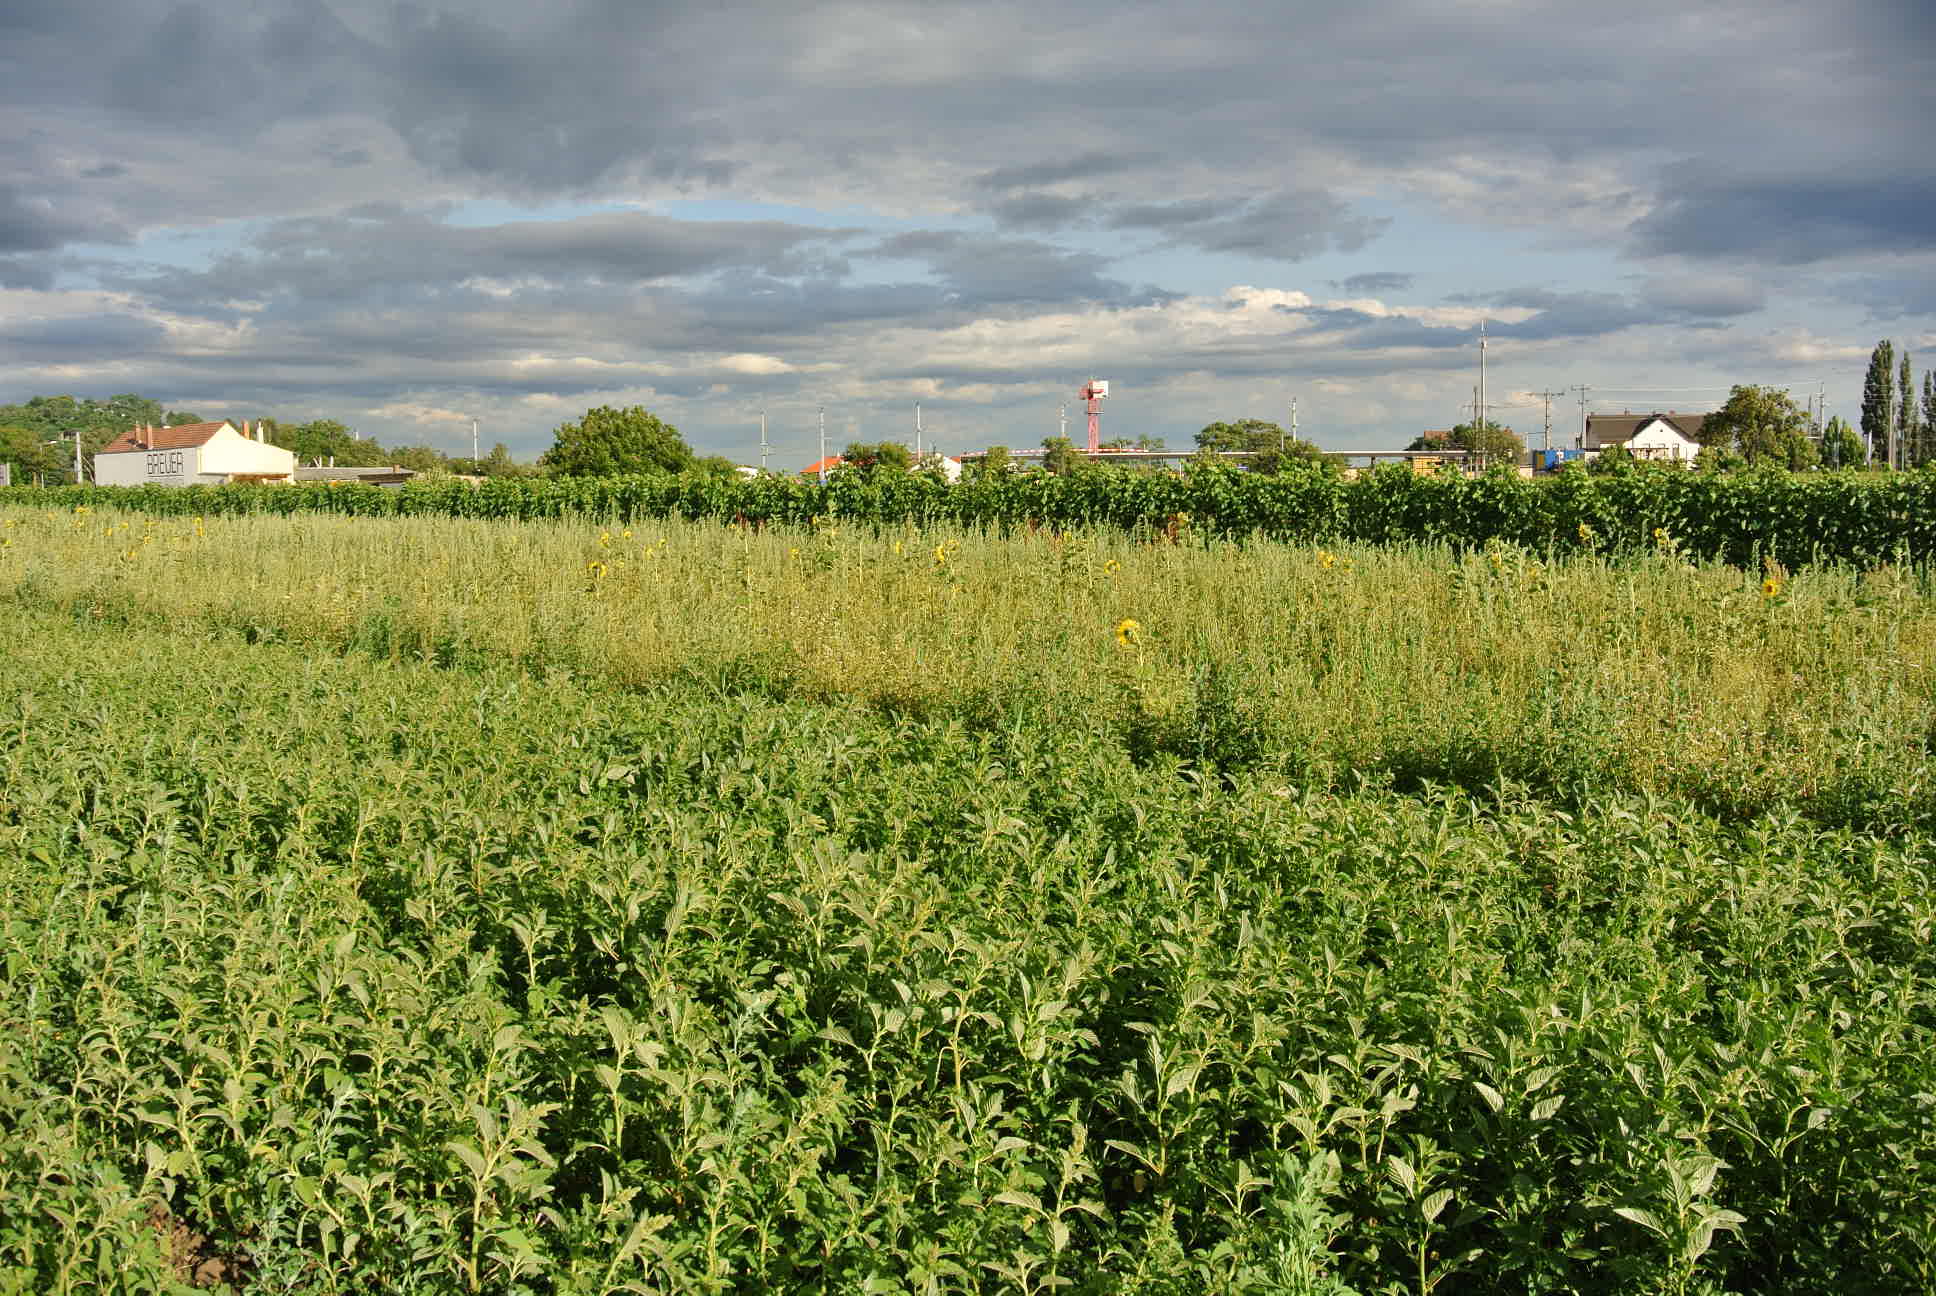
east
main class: Cropland
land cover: Other cereals
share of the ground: > 75 %
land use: Agriculture (excluding fallow land and kitchen gardens)
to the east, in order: Other cereals; Grass margins; Paved roads, cycling and walking lanes; Grass margins; Common wheat; Grassland without tree/shrub cover; Fences; Apple fruit; Fences; Grassland without tree/shrub cover
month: July
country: AT
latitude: 47.9579
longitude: 16.8226
